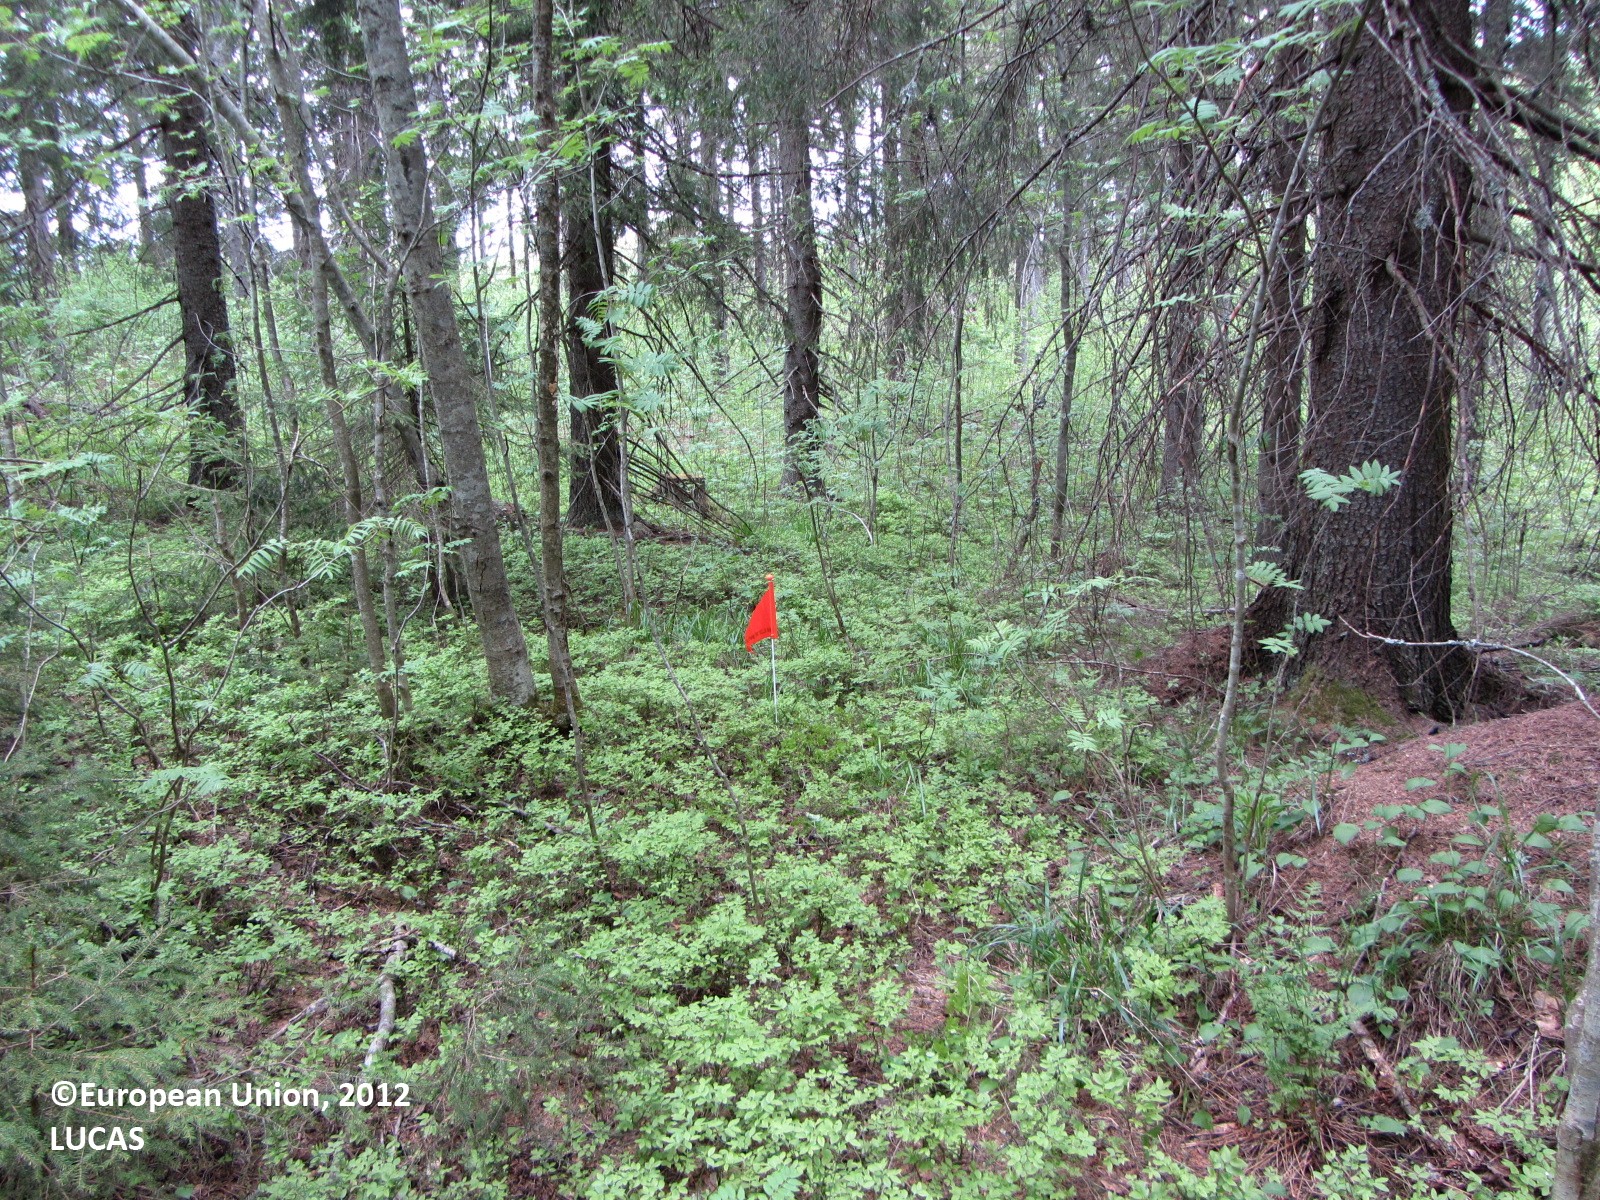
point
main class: Woodland
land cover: Spruce dominated mixed woodland
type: boreal forest
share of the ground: > 75 %
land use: Forestry
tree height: > 5 m
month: May
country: FI
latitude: 62.3060
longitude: 25.4459
